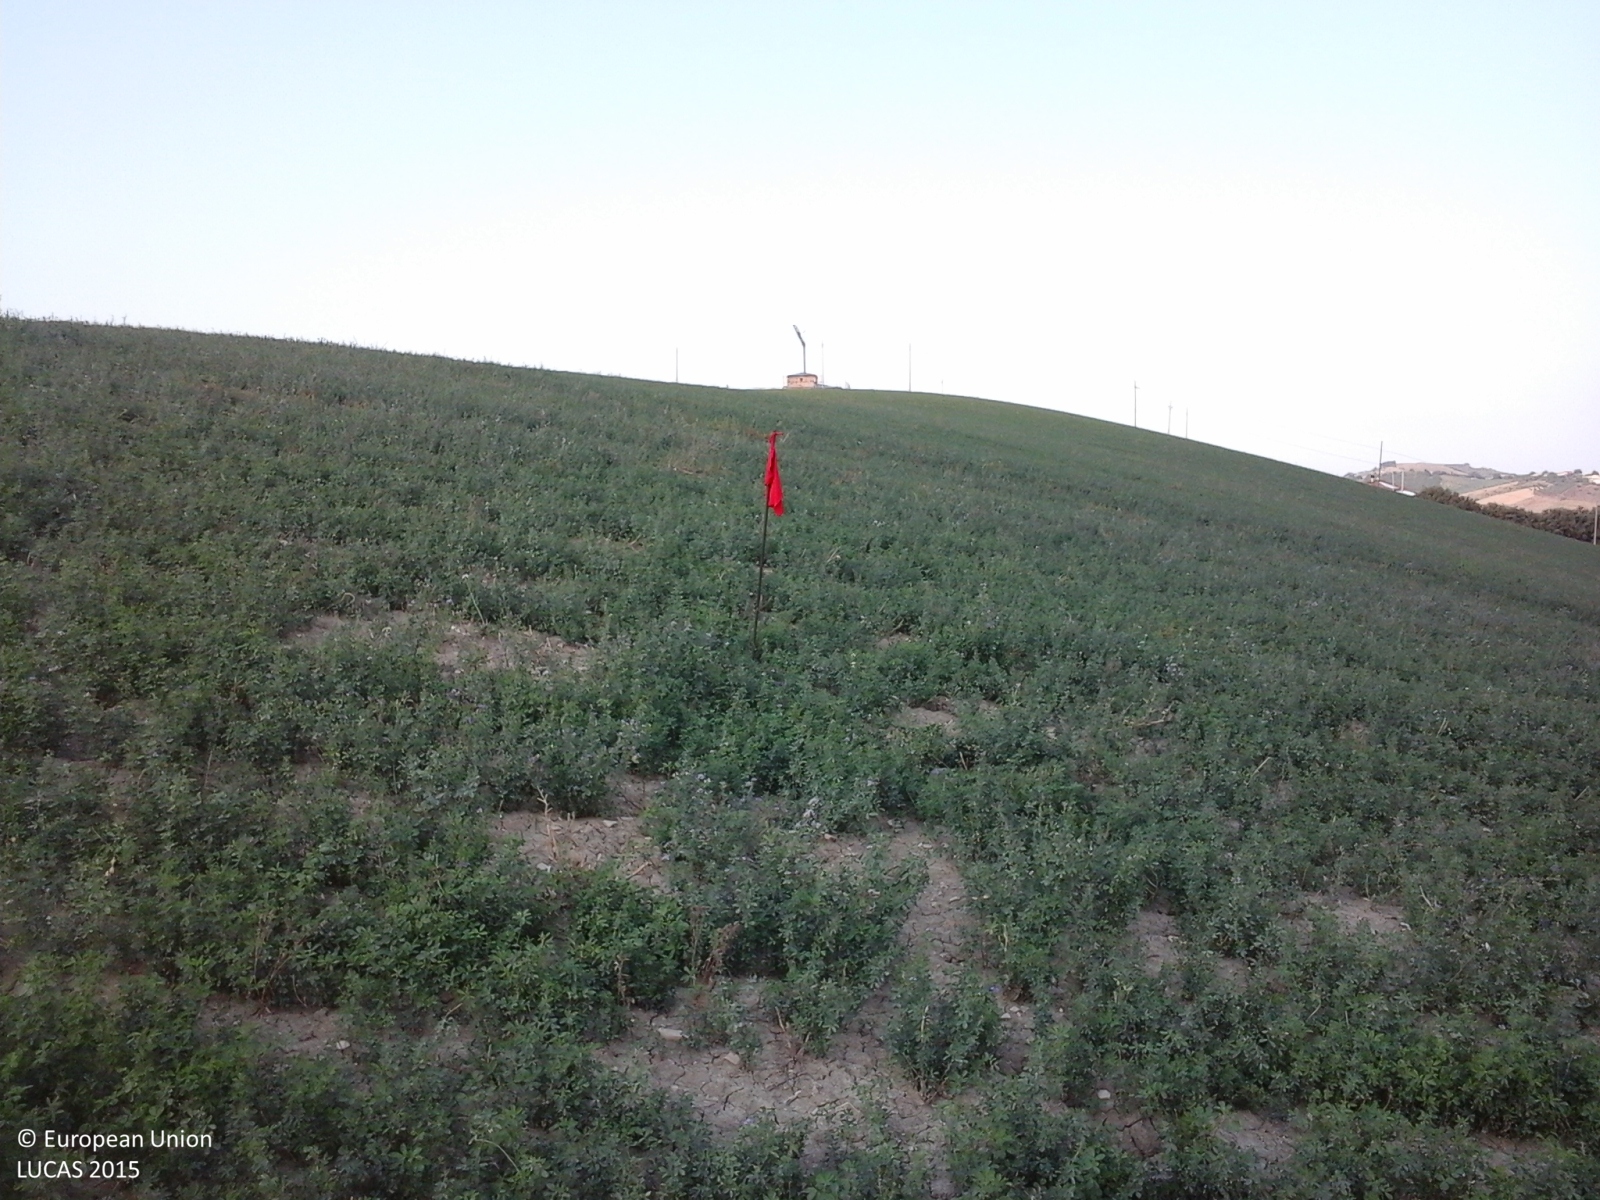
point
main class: Cropland
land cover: Lucerne
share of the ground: > 75 %
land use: Agriculture (excluding fallow land and kitchen gardens)
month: August
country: IT
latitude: 42.7098
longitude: 13.7862
